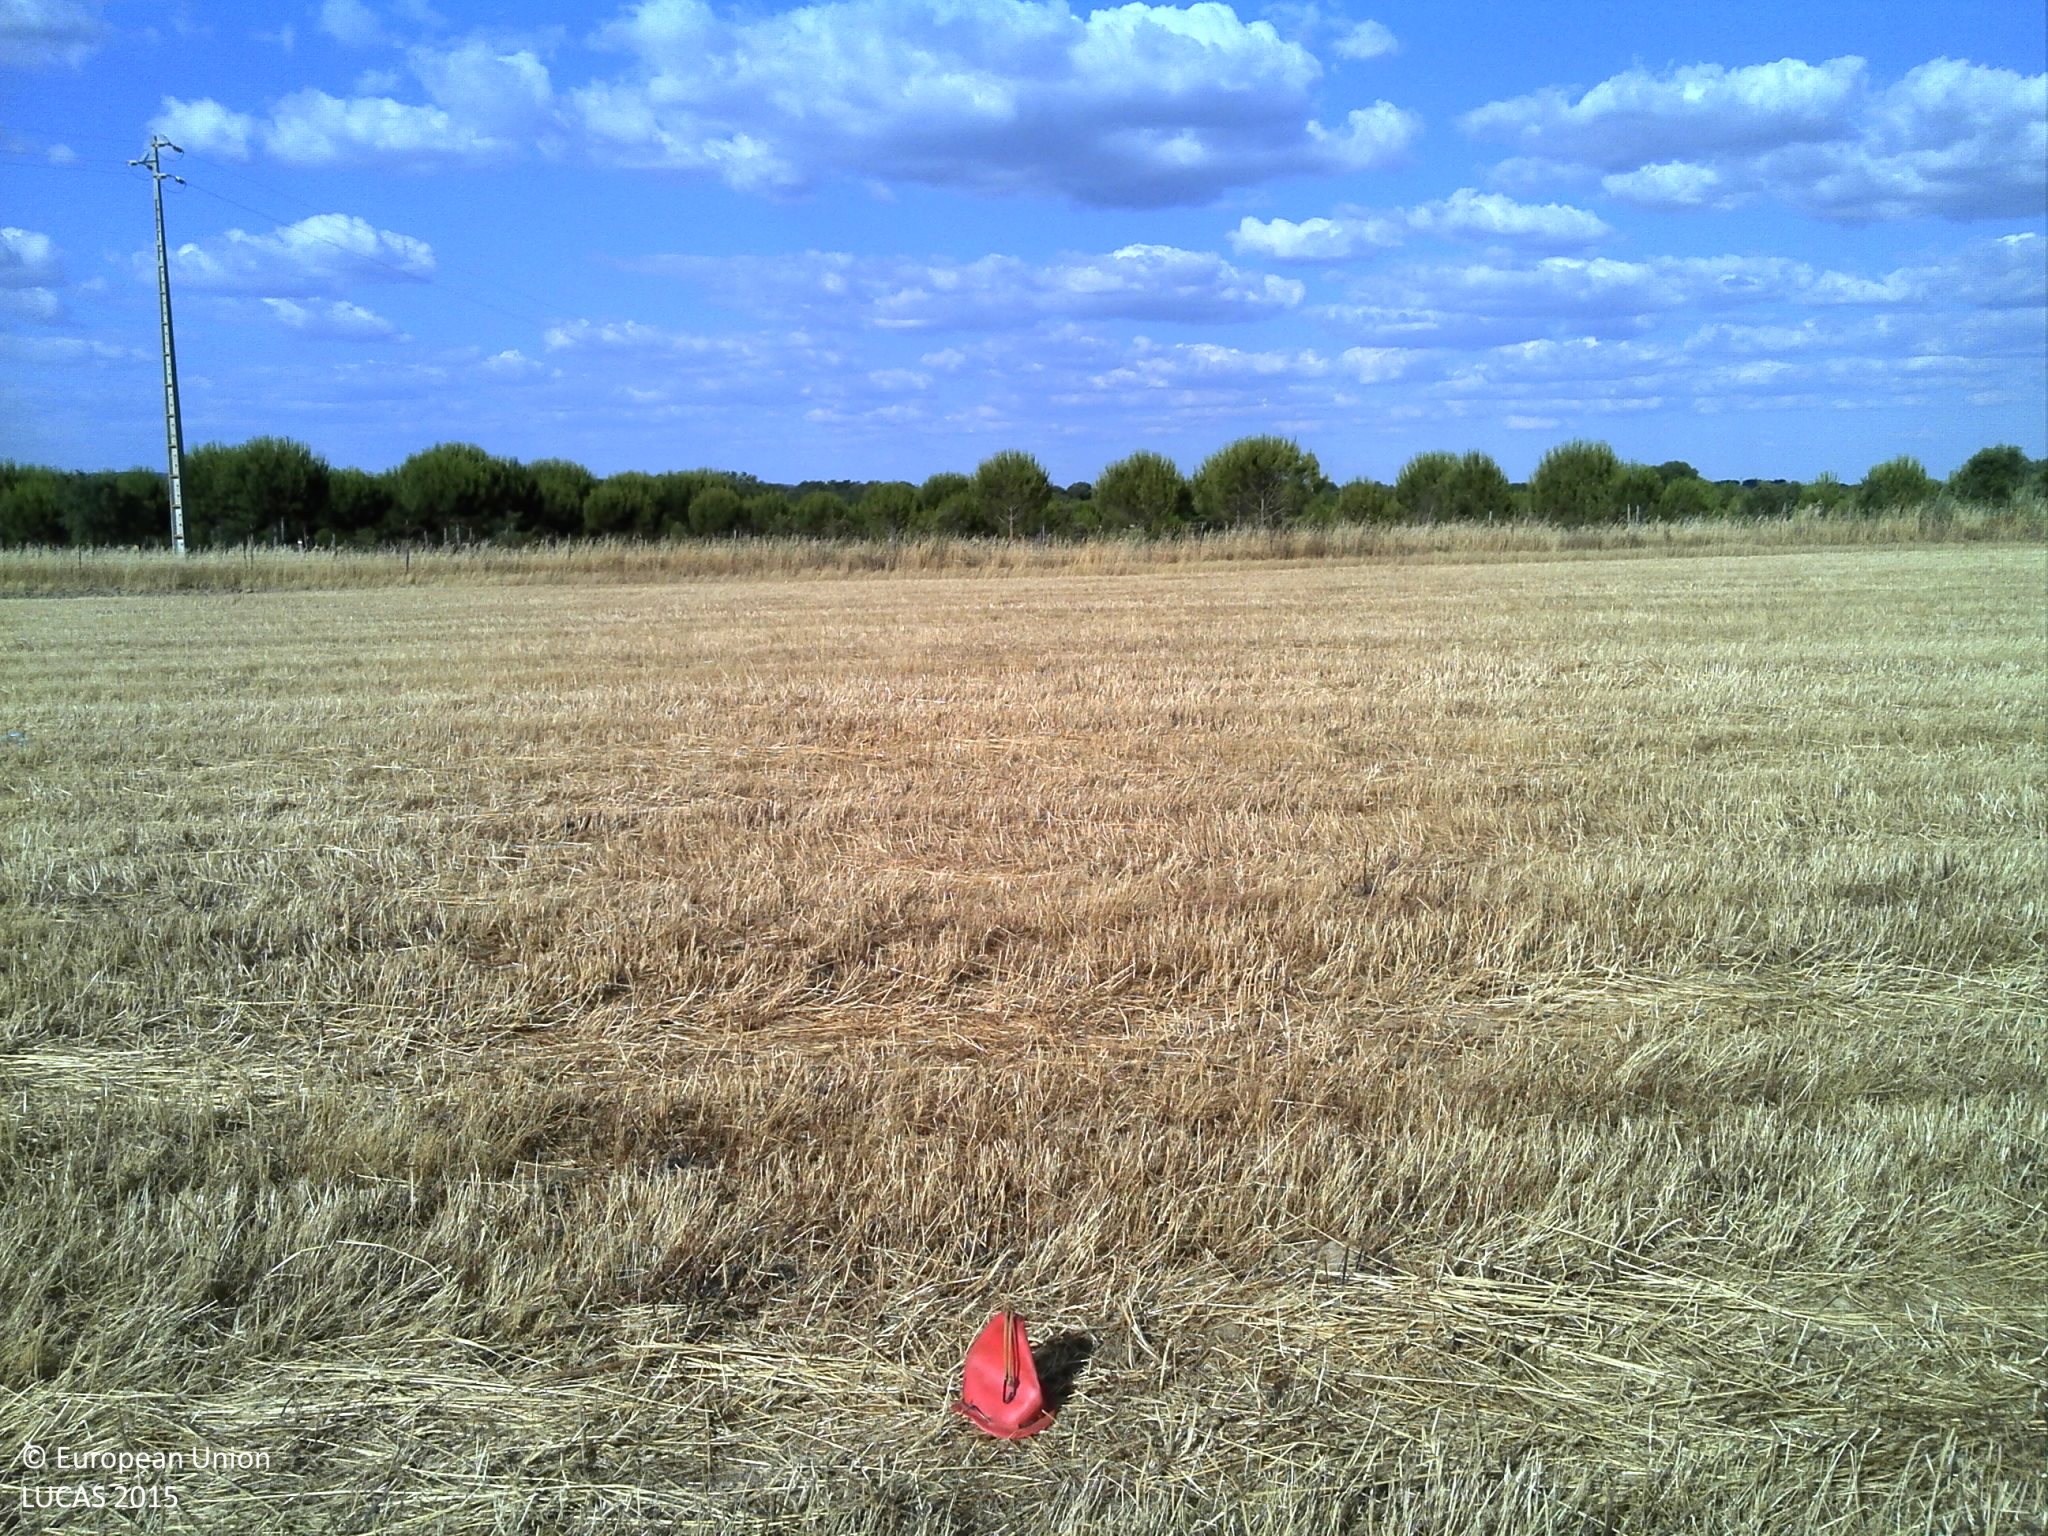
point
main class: Cropland
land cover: Temporary grasslands
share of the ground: 10 - 25 %
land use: Agriculture (excluding fallow land and kitchen gardens)
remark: Harvested field
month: June
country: PT
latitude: 38.4852
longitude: -8.1454
